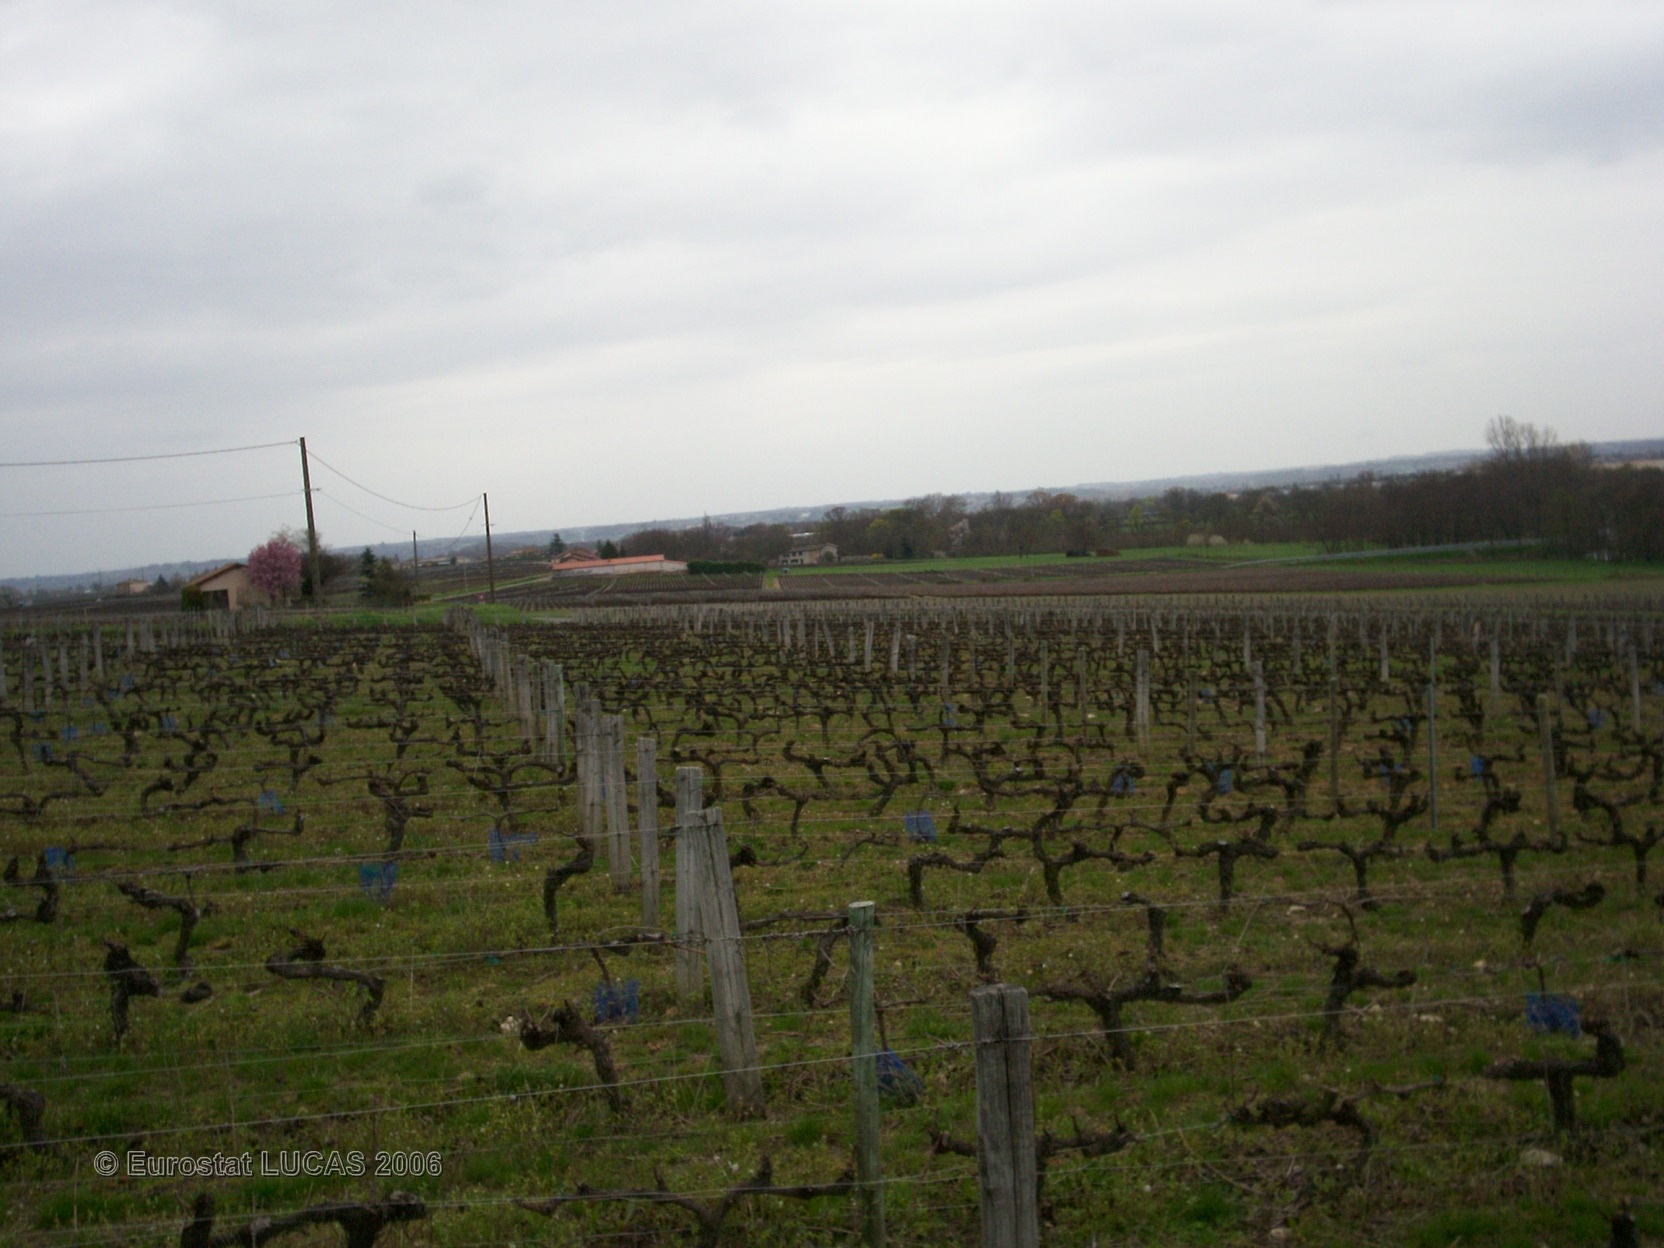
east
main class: Cropland
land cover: Vineyards
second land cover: Grassland without tree/shrub cover
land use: Agriculture (excluding fallow land and kitchen gardens)
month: April
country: FR
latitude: 46.1300
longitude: 4.7089
